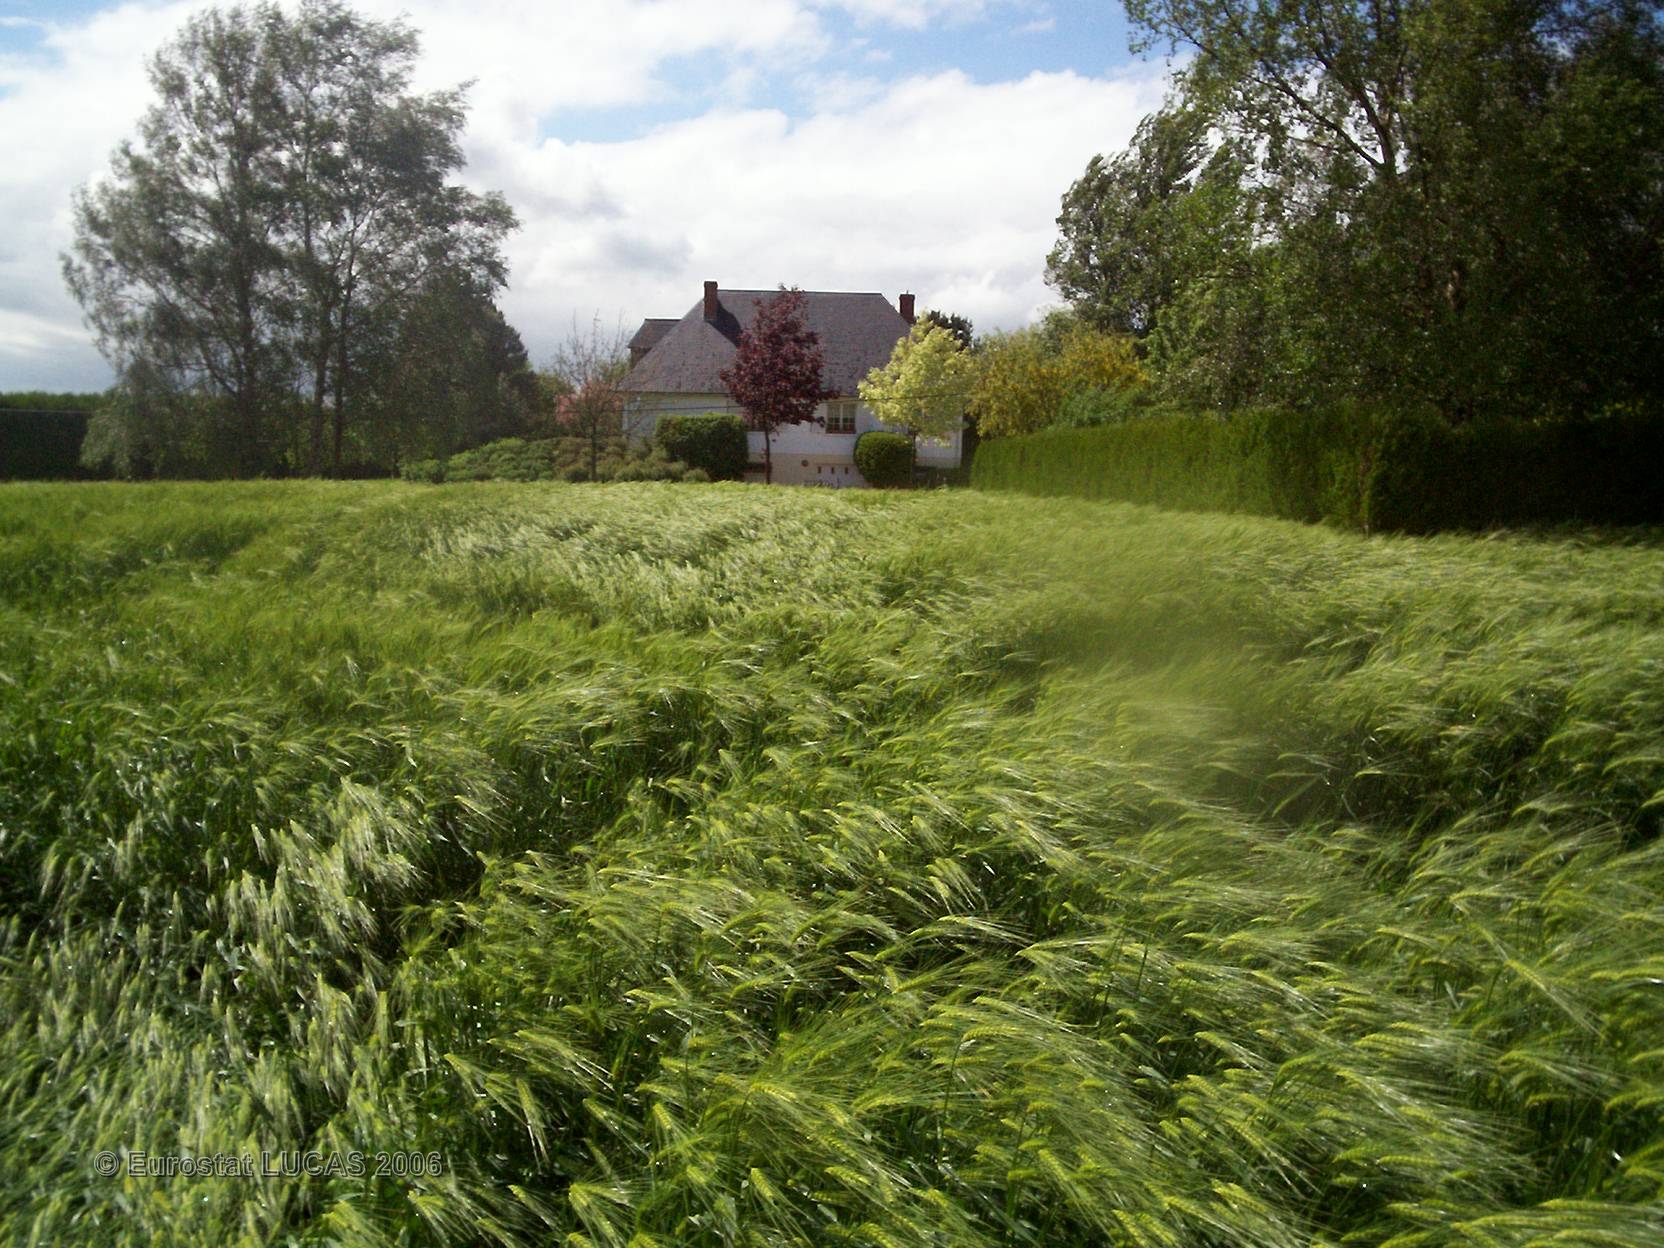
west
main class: Cropland
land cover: Barley
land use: Agriculture (excluding fallow land and kitchen gardens)
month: May
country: FR
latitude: 49.5448
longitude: 0.4225
